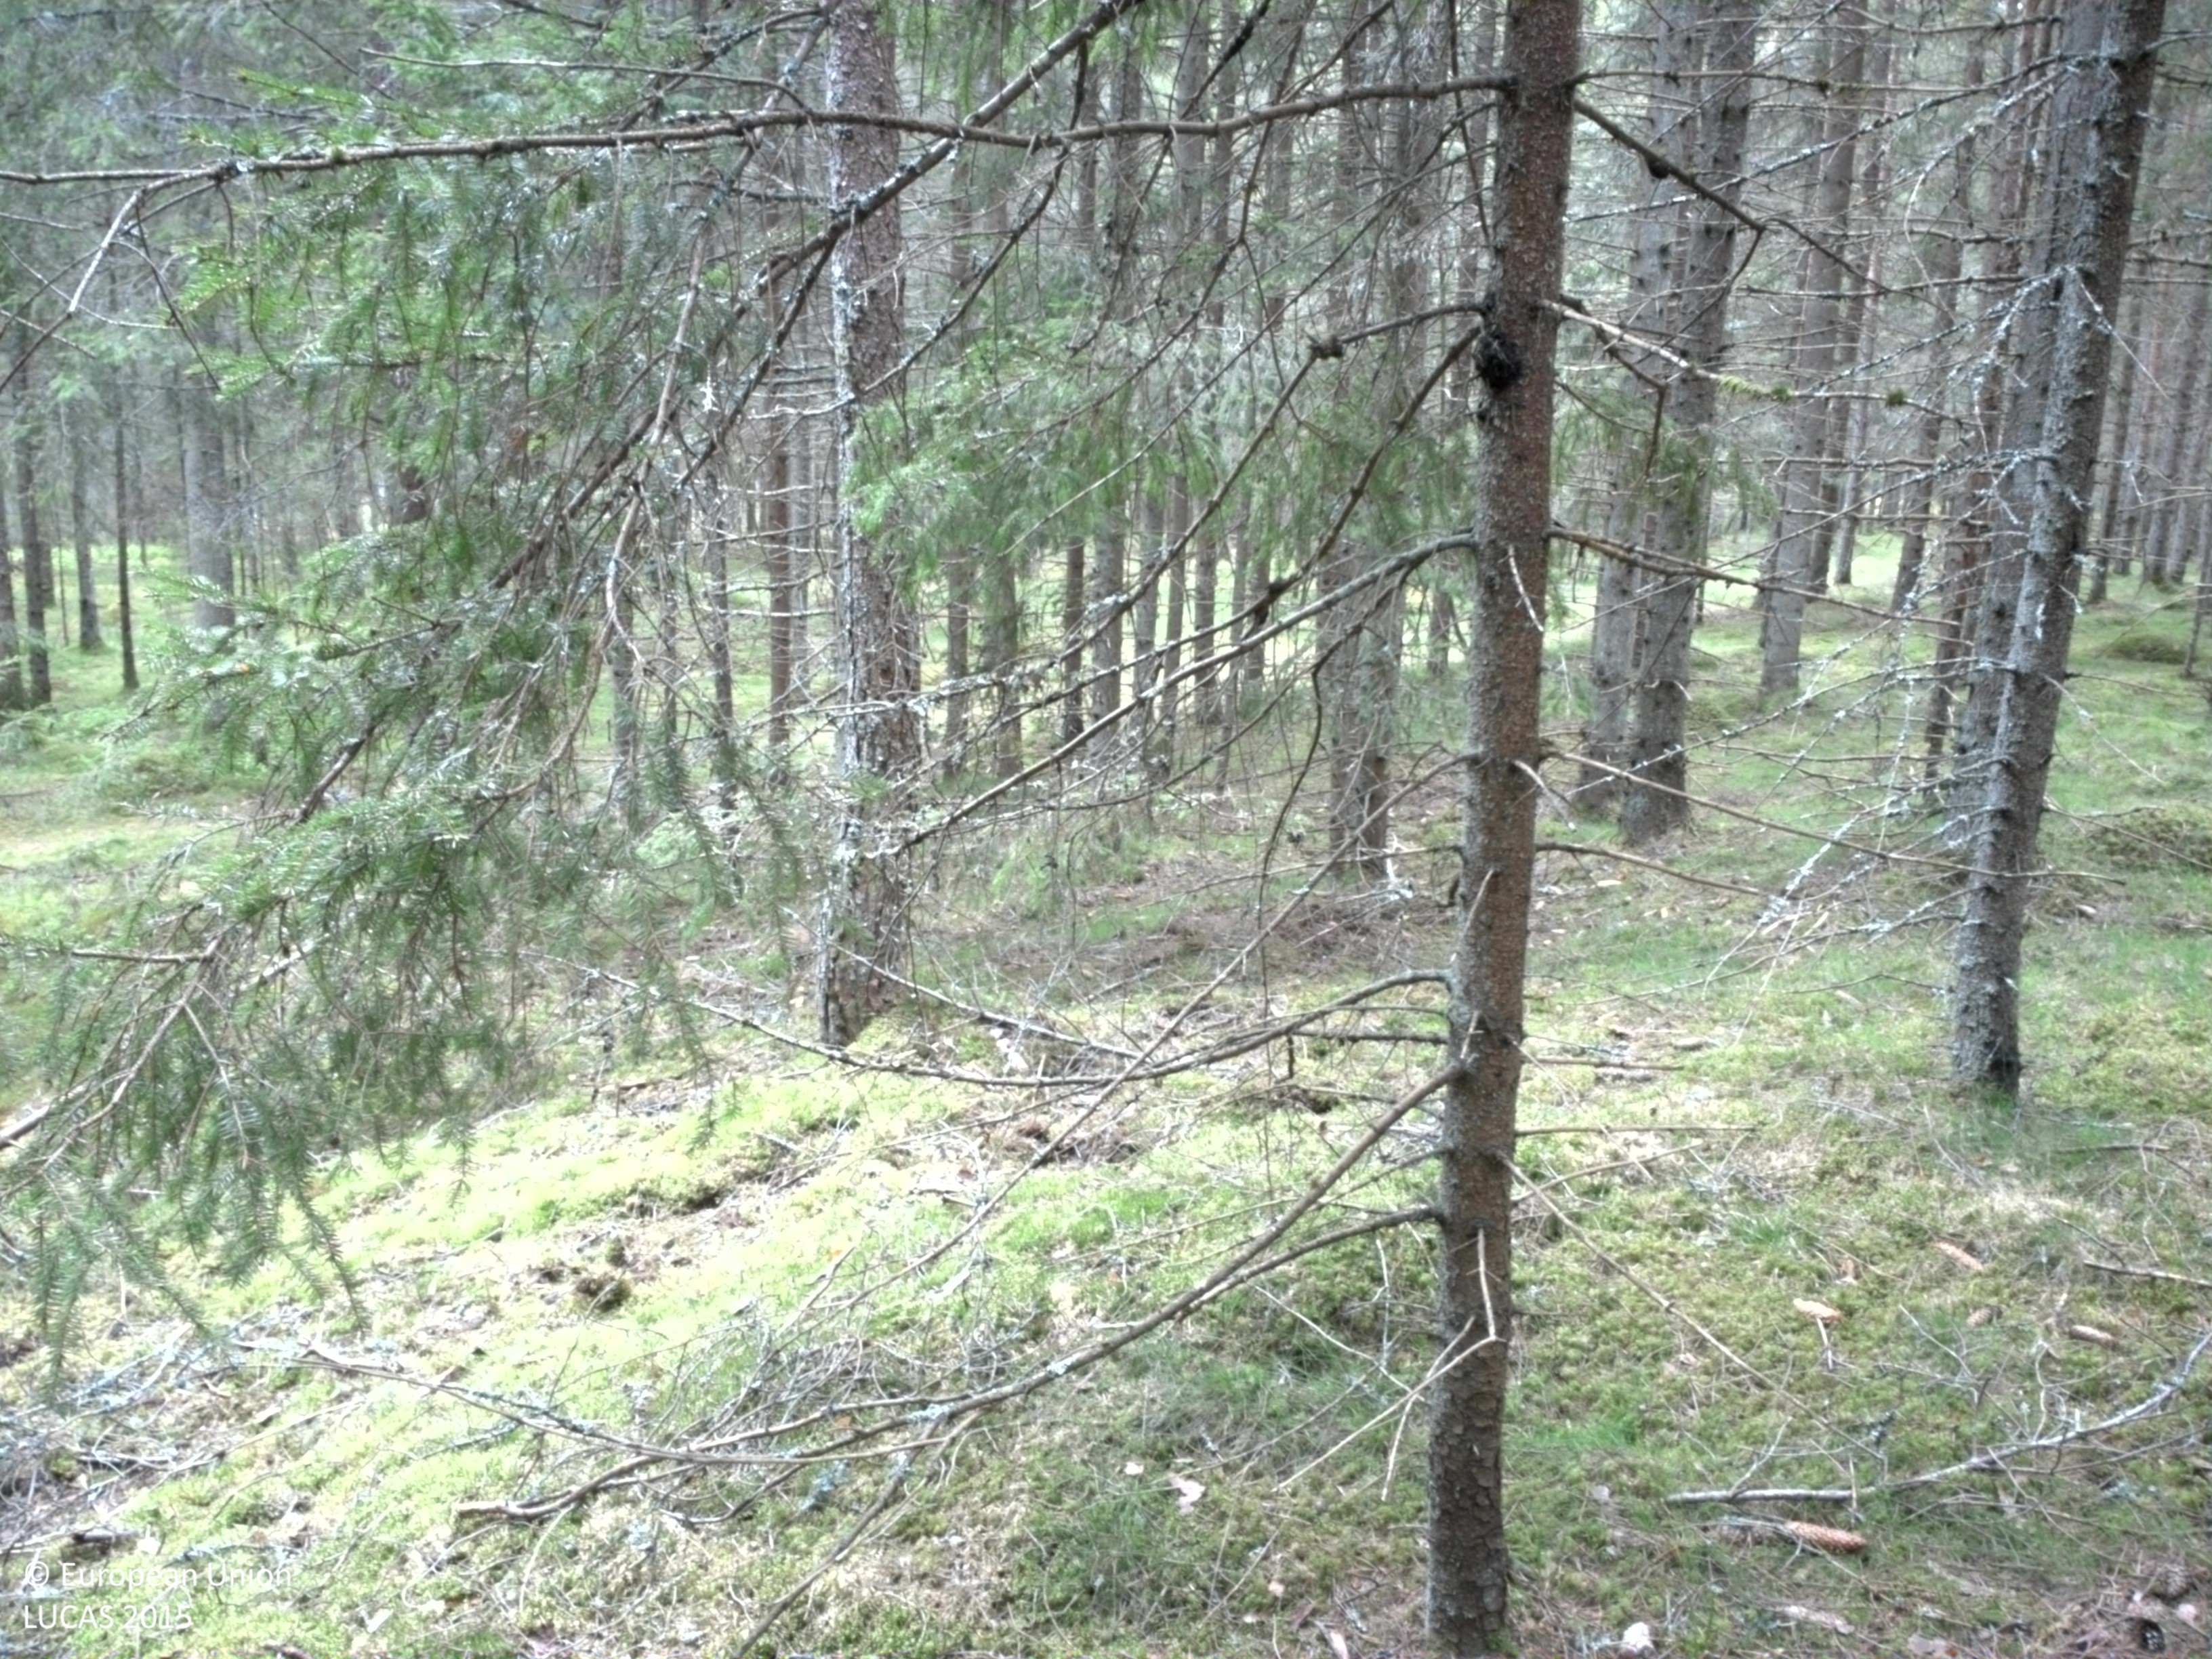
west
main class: Woodland
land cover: Spruce dominated coniferous woodland
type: boreal forest
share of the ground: > 75 %
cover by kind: coniferous forest trees 85 %, lichens and mosses 10 %, herbaceous plants 5 %
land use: Forestry
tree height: > 5 m
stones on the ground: < 10 %
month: May
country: SE
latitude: 56.6013
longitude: 15.2922
